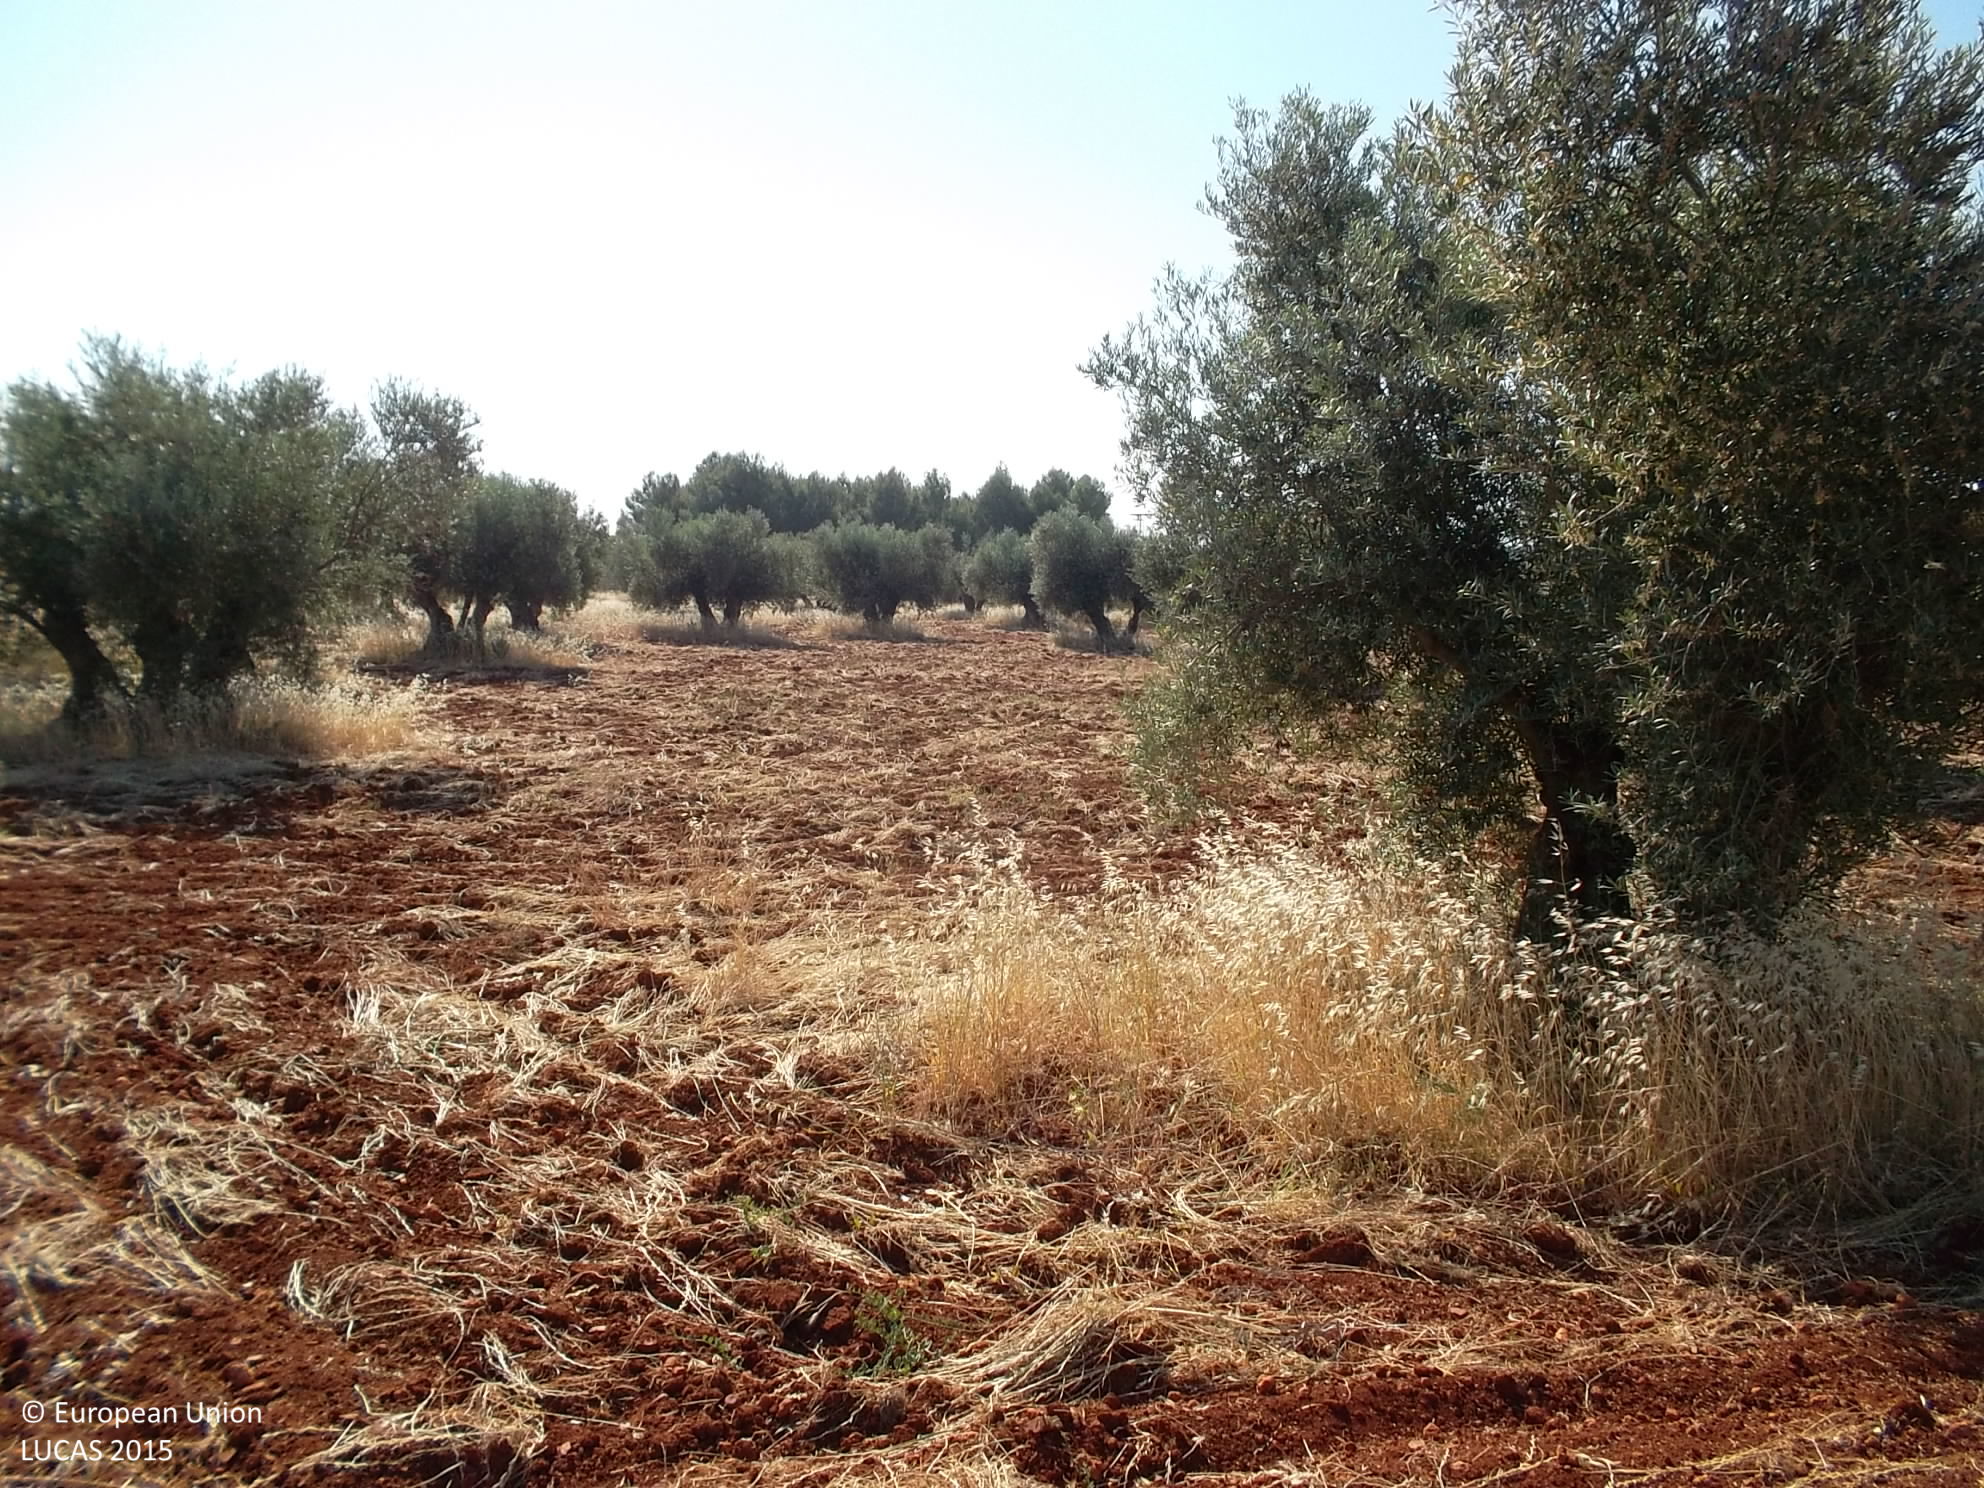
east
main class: Cropland
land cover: Olive groves
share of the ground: 10 - 25 %
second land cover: Other bare soil
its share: > 75 %
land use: Agriculture (excluding fallow land and kitchen gardens)
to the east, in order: Olive groves; Other bare soil; Grass margins; Olive groves; Other bare soil; Grass margins; Grassland without tree/shrub cover; Tracks; Fences; Artificial constructions in urban areas; Fences; Common wheat
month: June
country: ES
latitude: 38.7416
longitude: -4.0196
